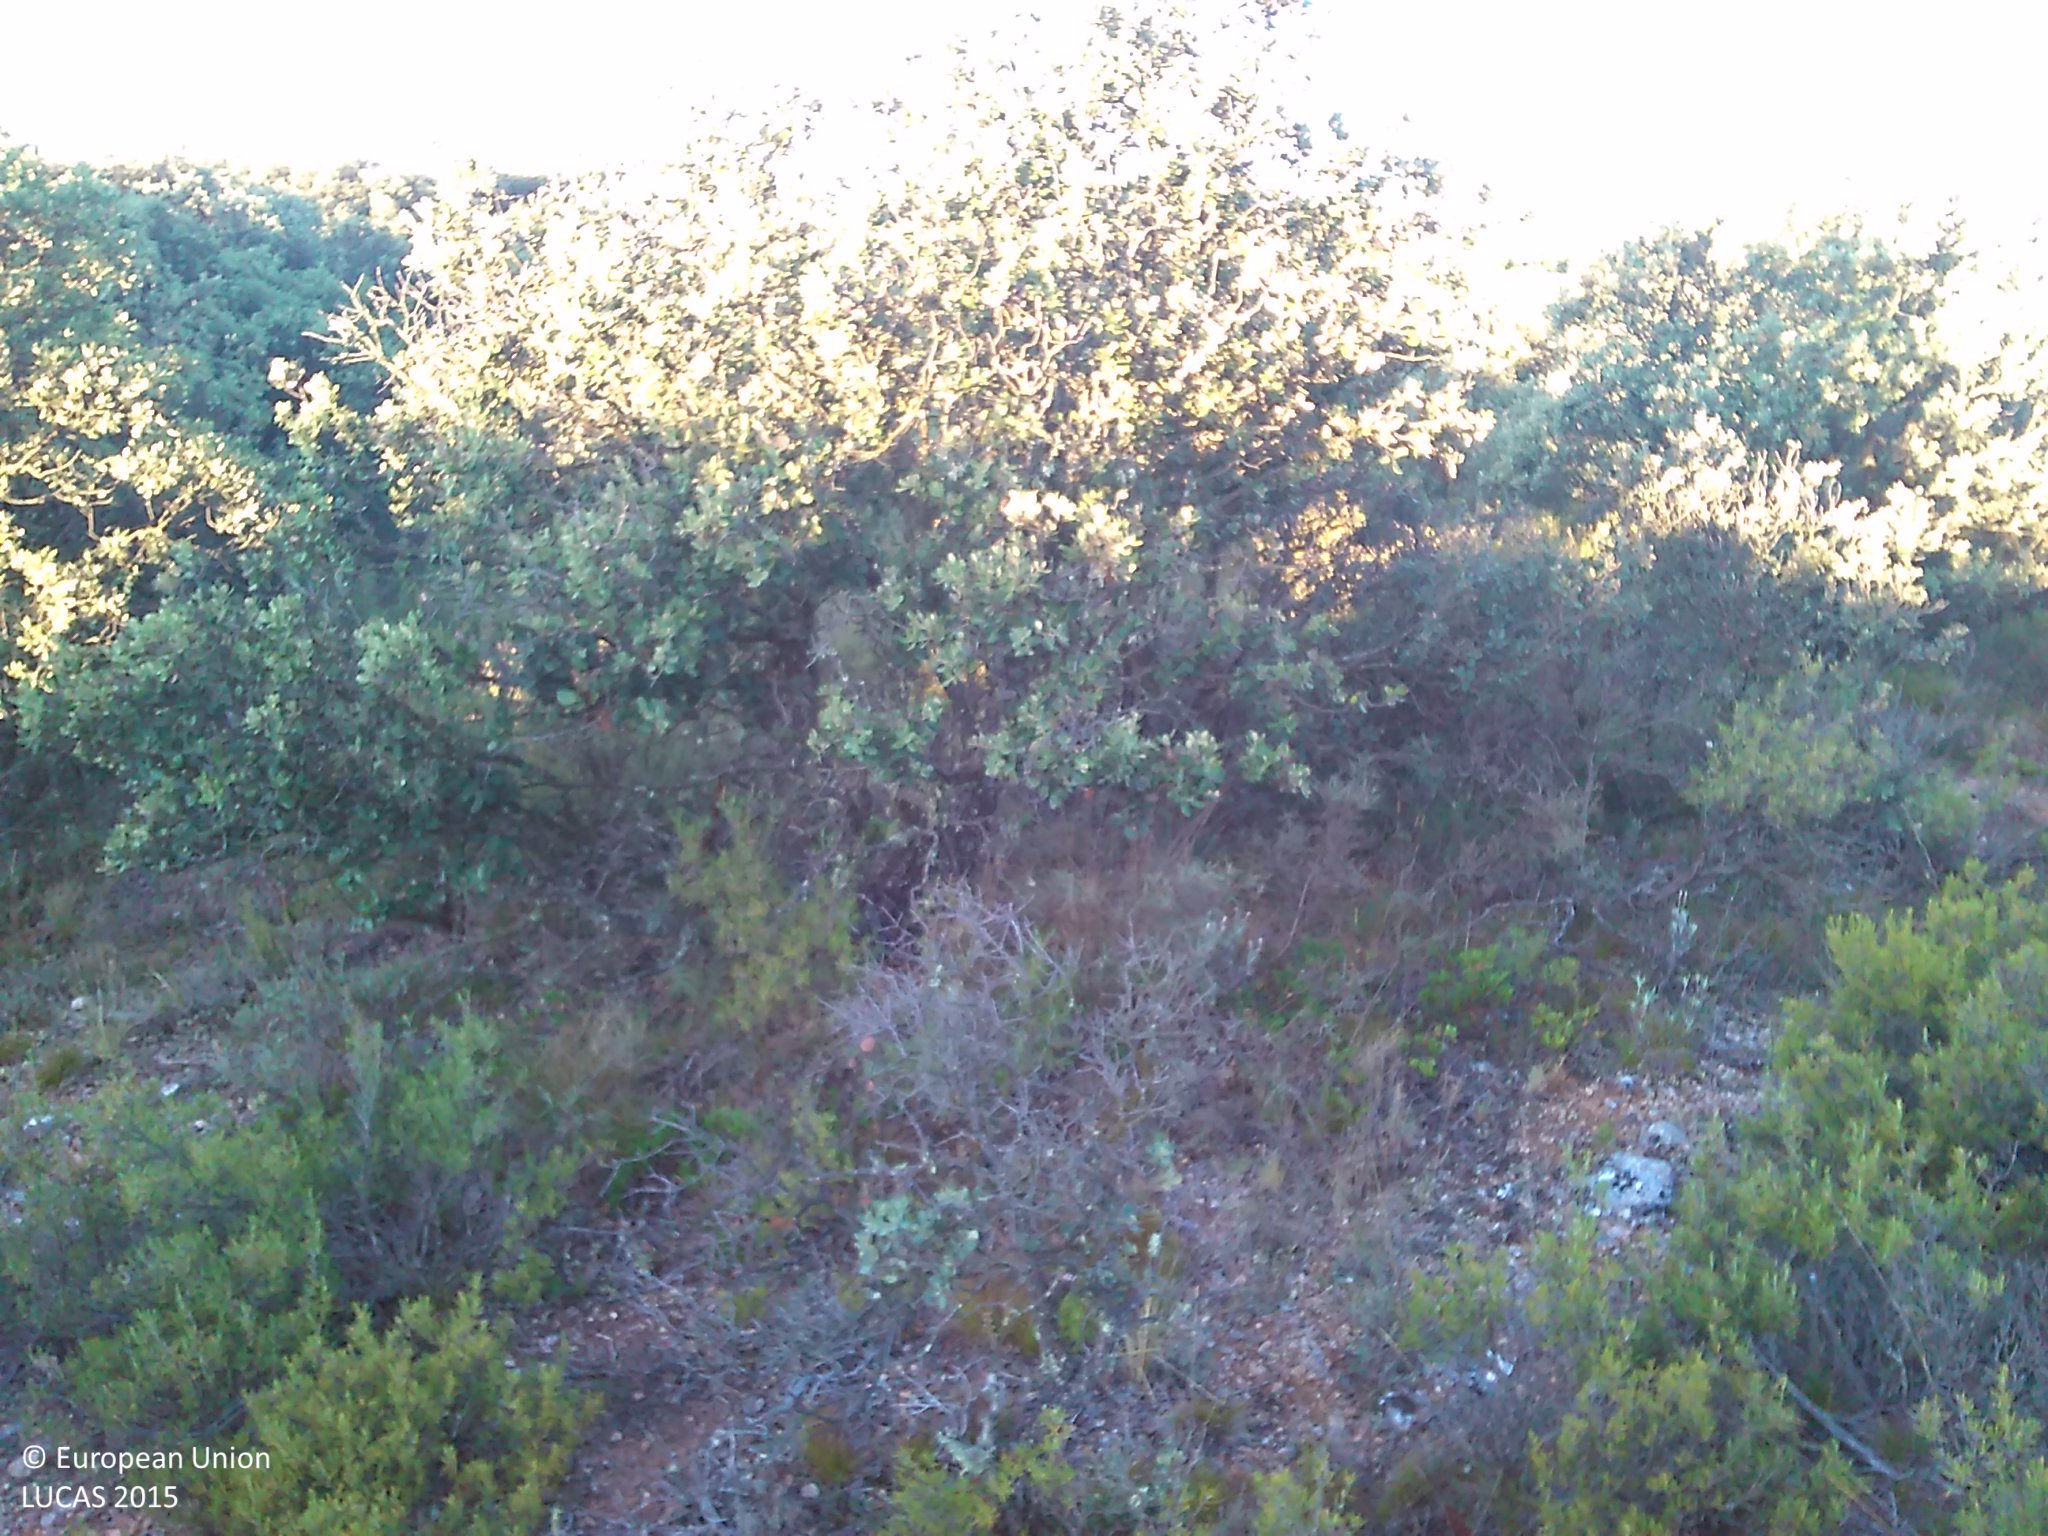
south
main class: Woodland
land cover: Broadleaved woodland
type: broadleaved evergreen forest
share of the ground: 50 - 75 %
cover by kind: broadleaved forest trees 50 %, shrubs 30 %, unconsolidated bare surface 15 %, herbaceous plants 5 %
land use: Semi-natural and natural areas not in use
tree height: < 5 m
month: July
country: ES
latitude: 41.4859
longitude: -2.1159
